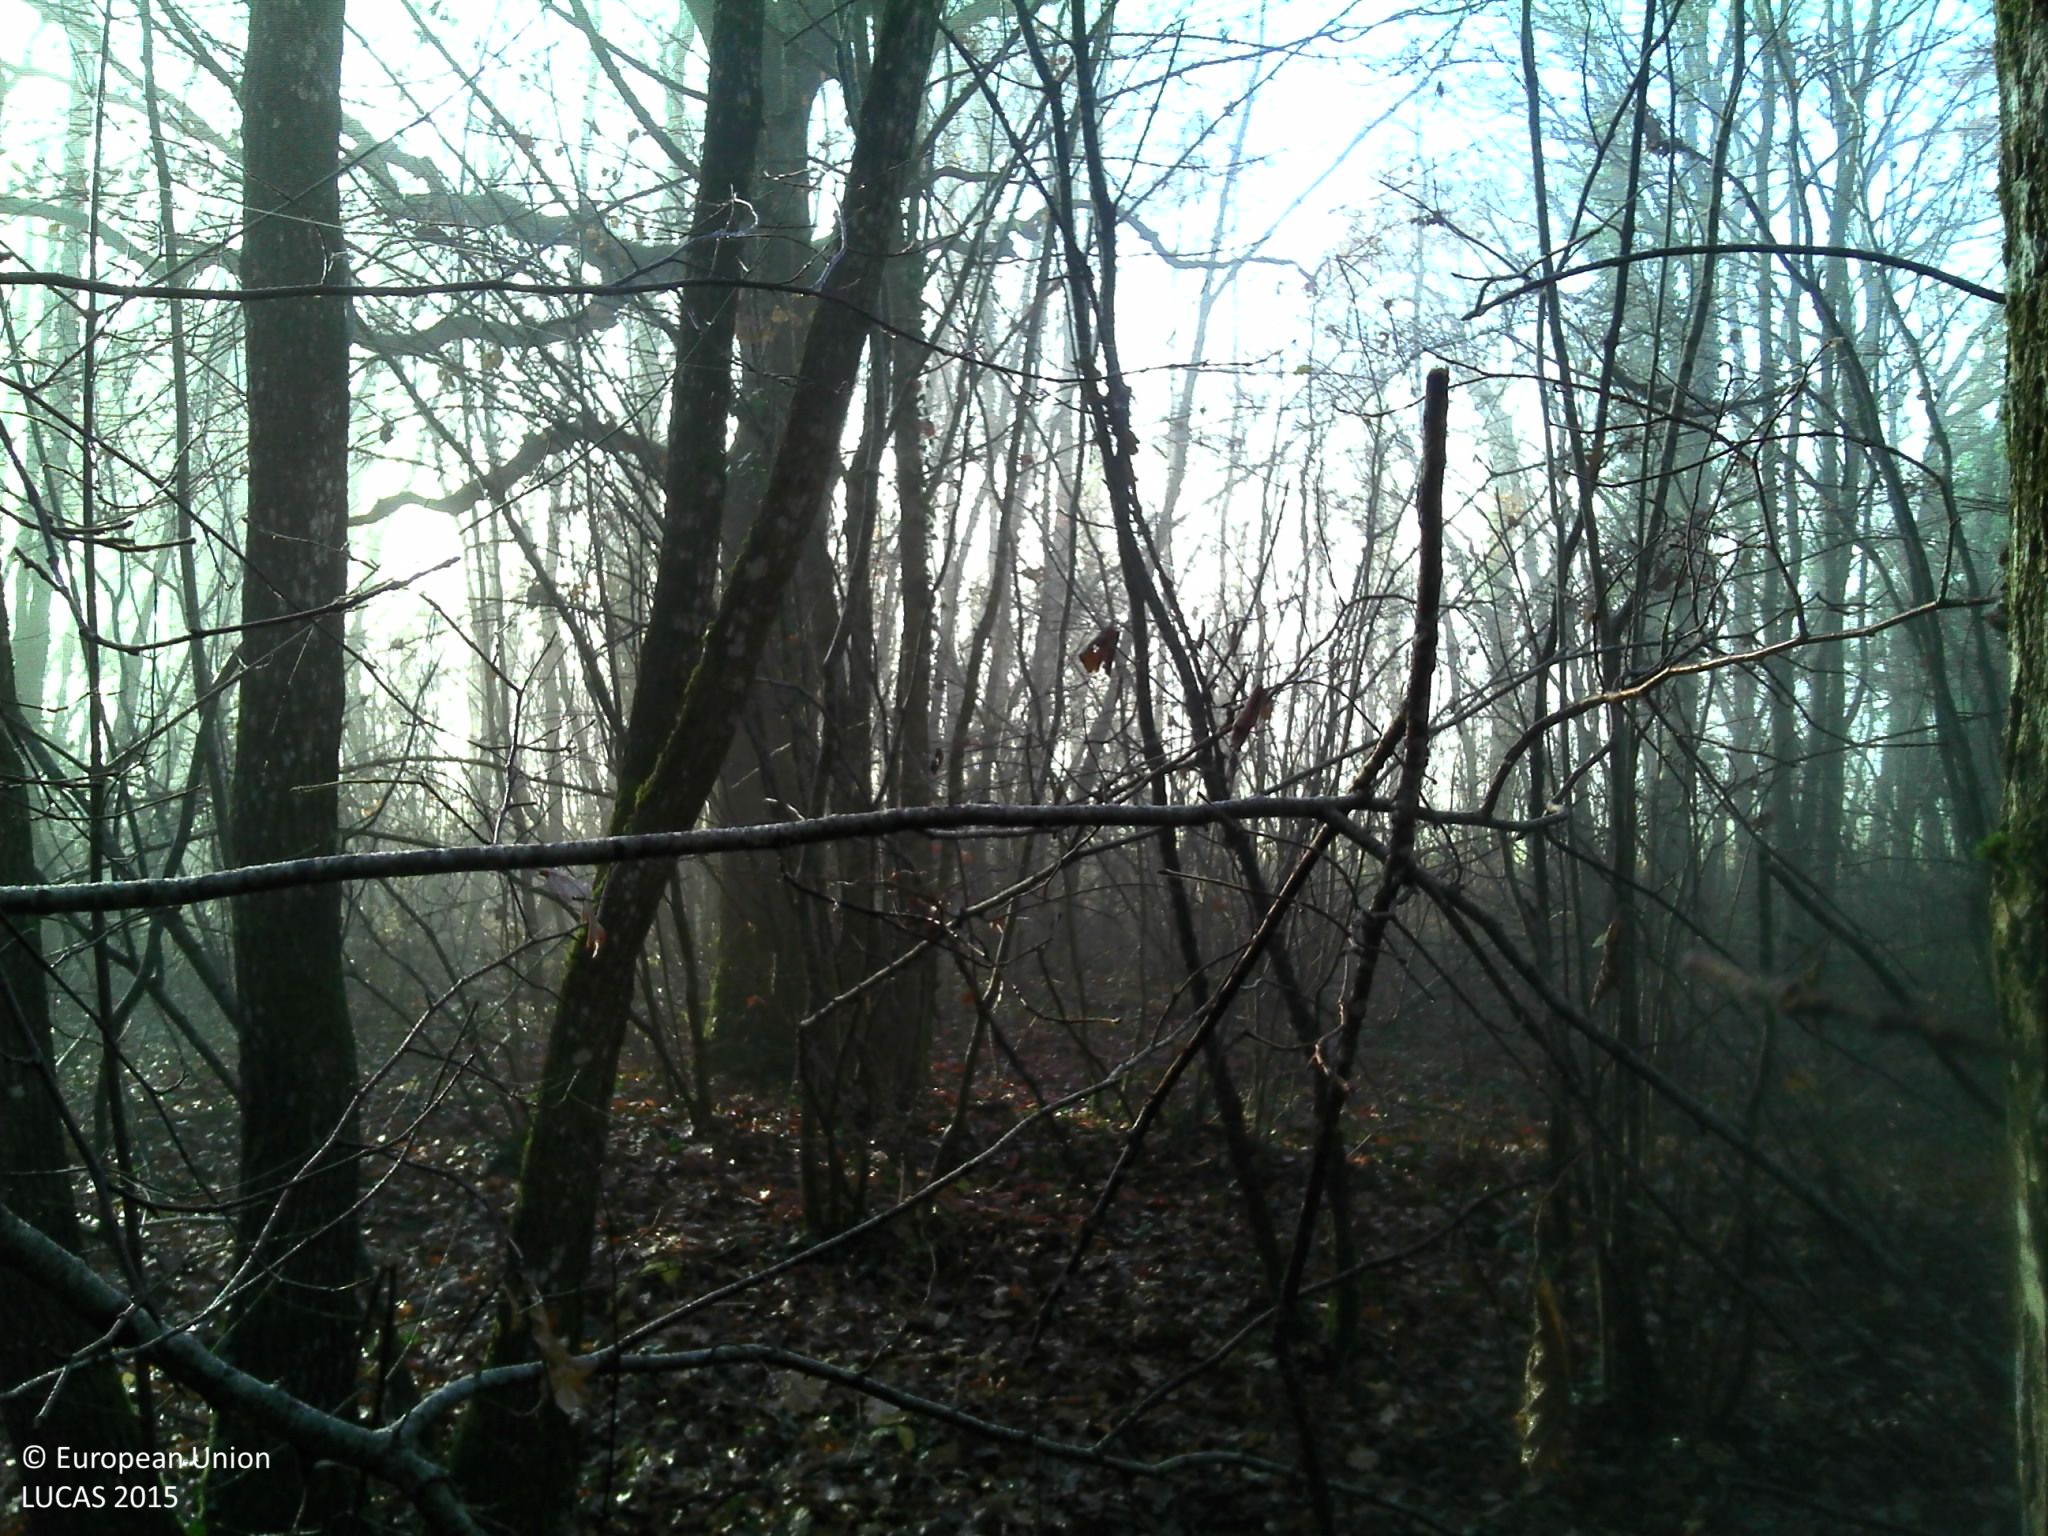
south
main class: Woodland
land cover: Broadleaved woodland
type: mesophytic deciduous forest
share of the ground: > 75 %
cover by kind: broadleaved forest trees 100 %
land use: Forestry
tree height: > 5 m
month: December
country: FR
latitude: 47.4514
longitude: 3.1646
